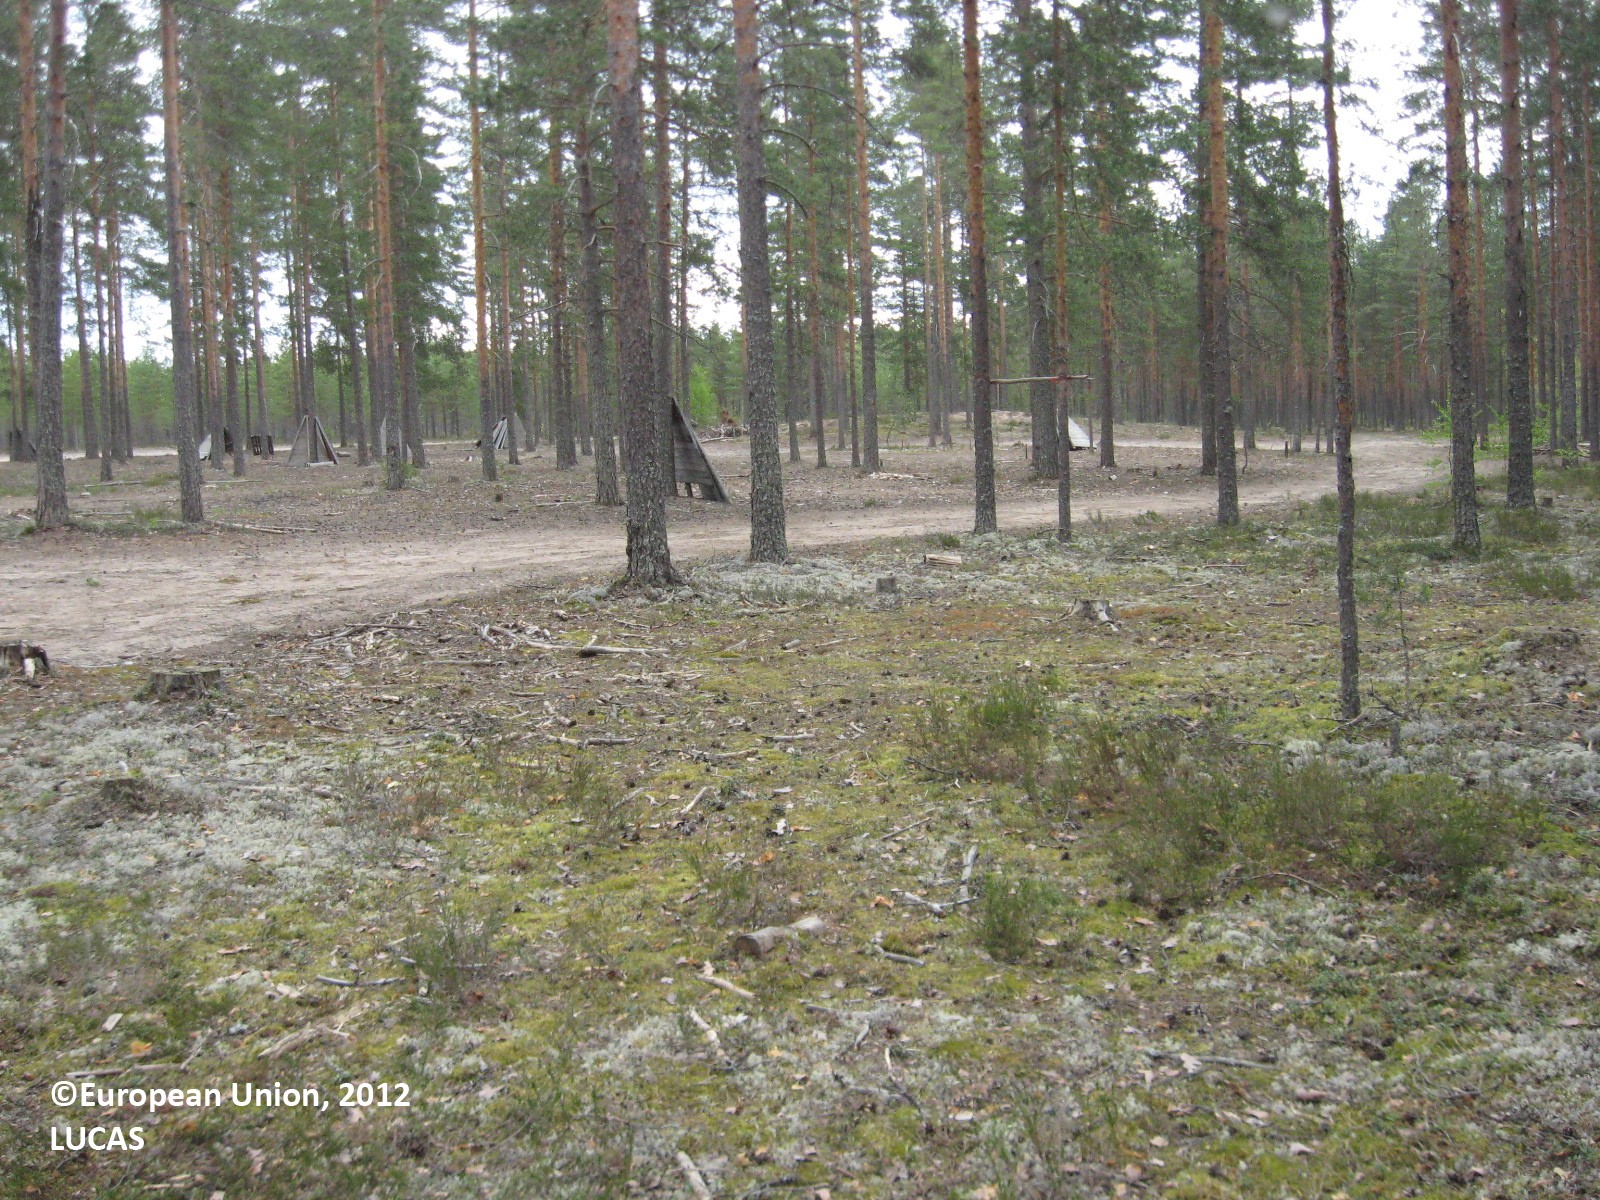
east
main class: Woodland
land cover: Pine dominated coniferous woodland
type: boreal forest
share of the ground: 50 - 75 %
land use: Community services
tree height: > 5 m
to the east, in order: Pine dominated coniferous woodland; Tracks; Pine dominated coniferous woodland; Tracks; Pine dominated coniferous woodland; Tracks; Pine dominated coniferous woodland; Tracks; Pine dominated coniferous woodland
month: May
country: FI
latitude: 61.7640
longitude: 22.6639
